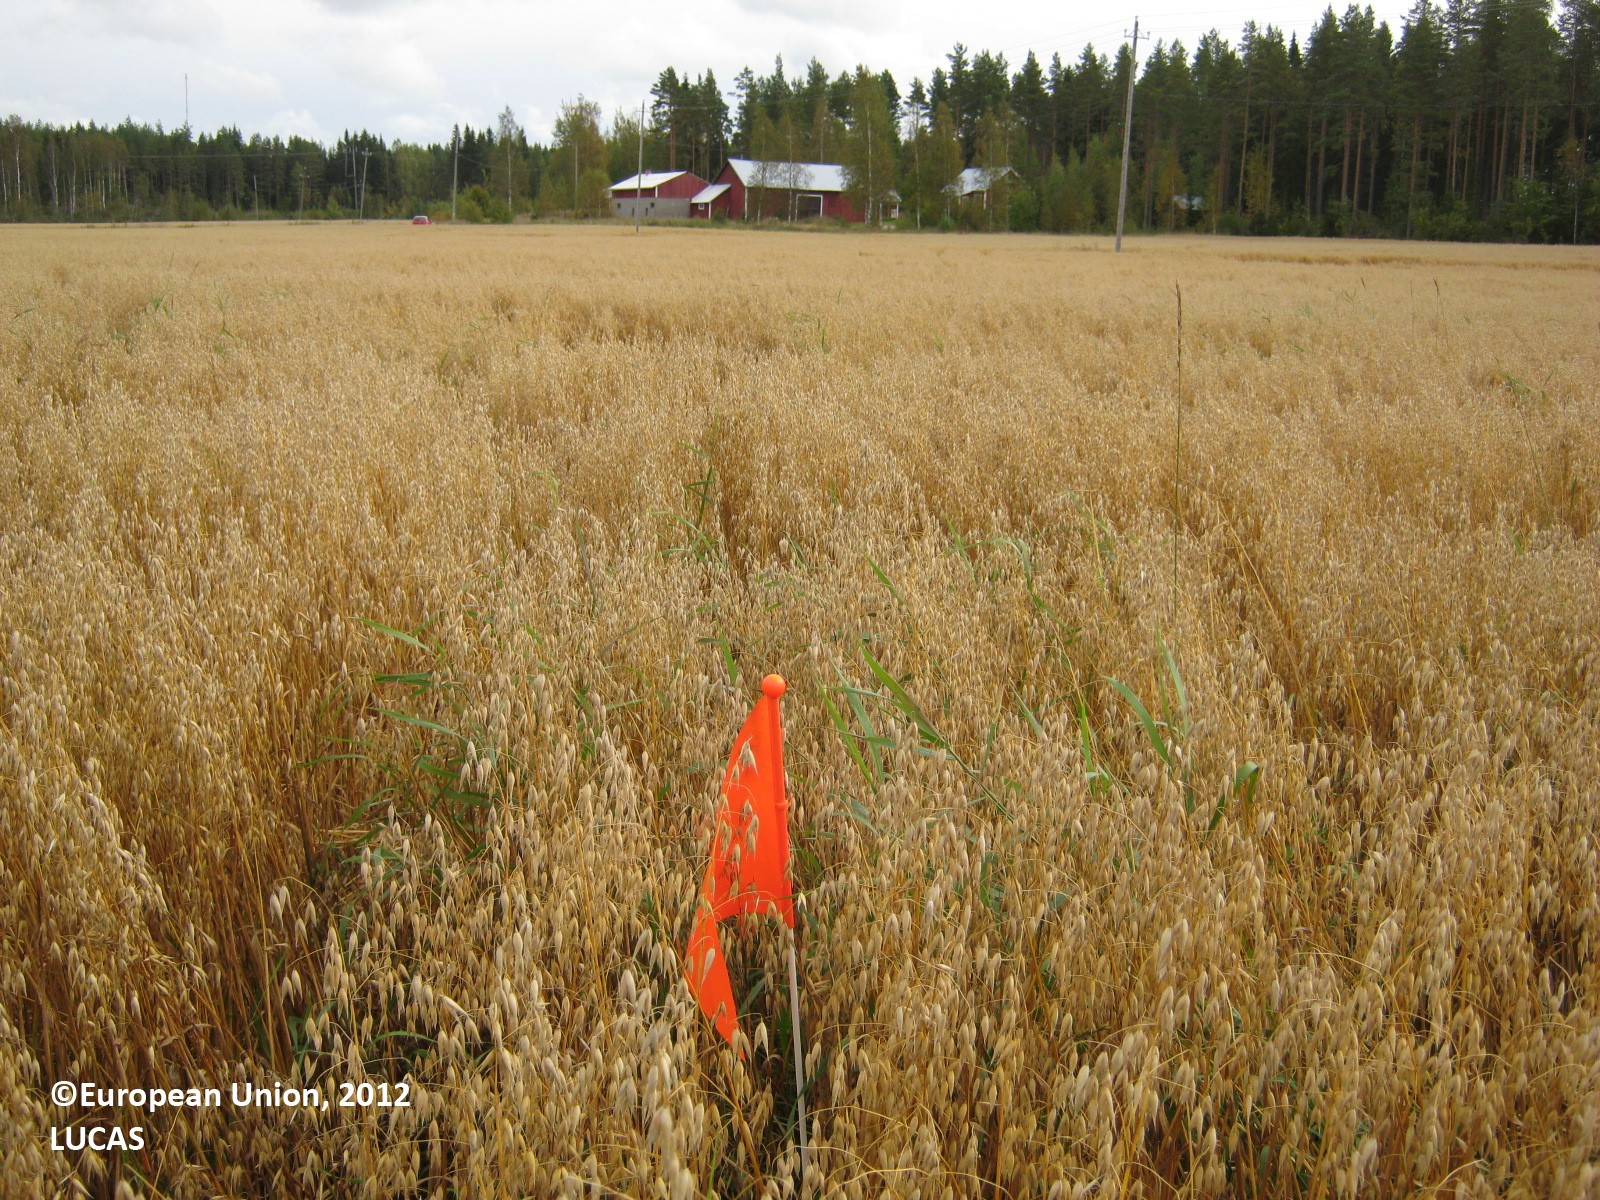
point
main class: Cropland
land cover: Oats
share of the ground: > 75 %
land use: Agriculture (excluding fallow land and kitchen gardens)
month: September
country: FI
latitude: 60.6851
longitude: 27.6389
